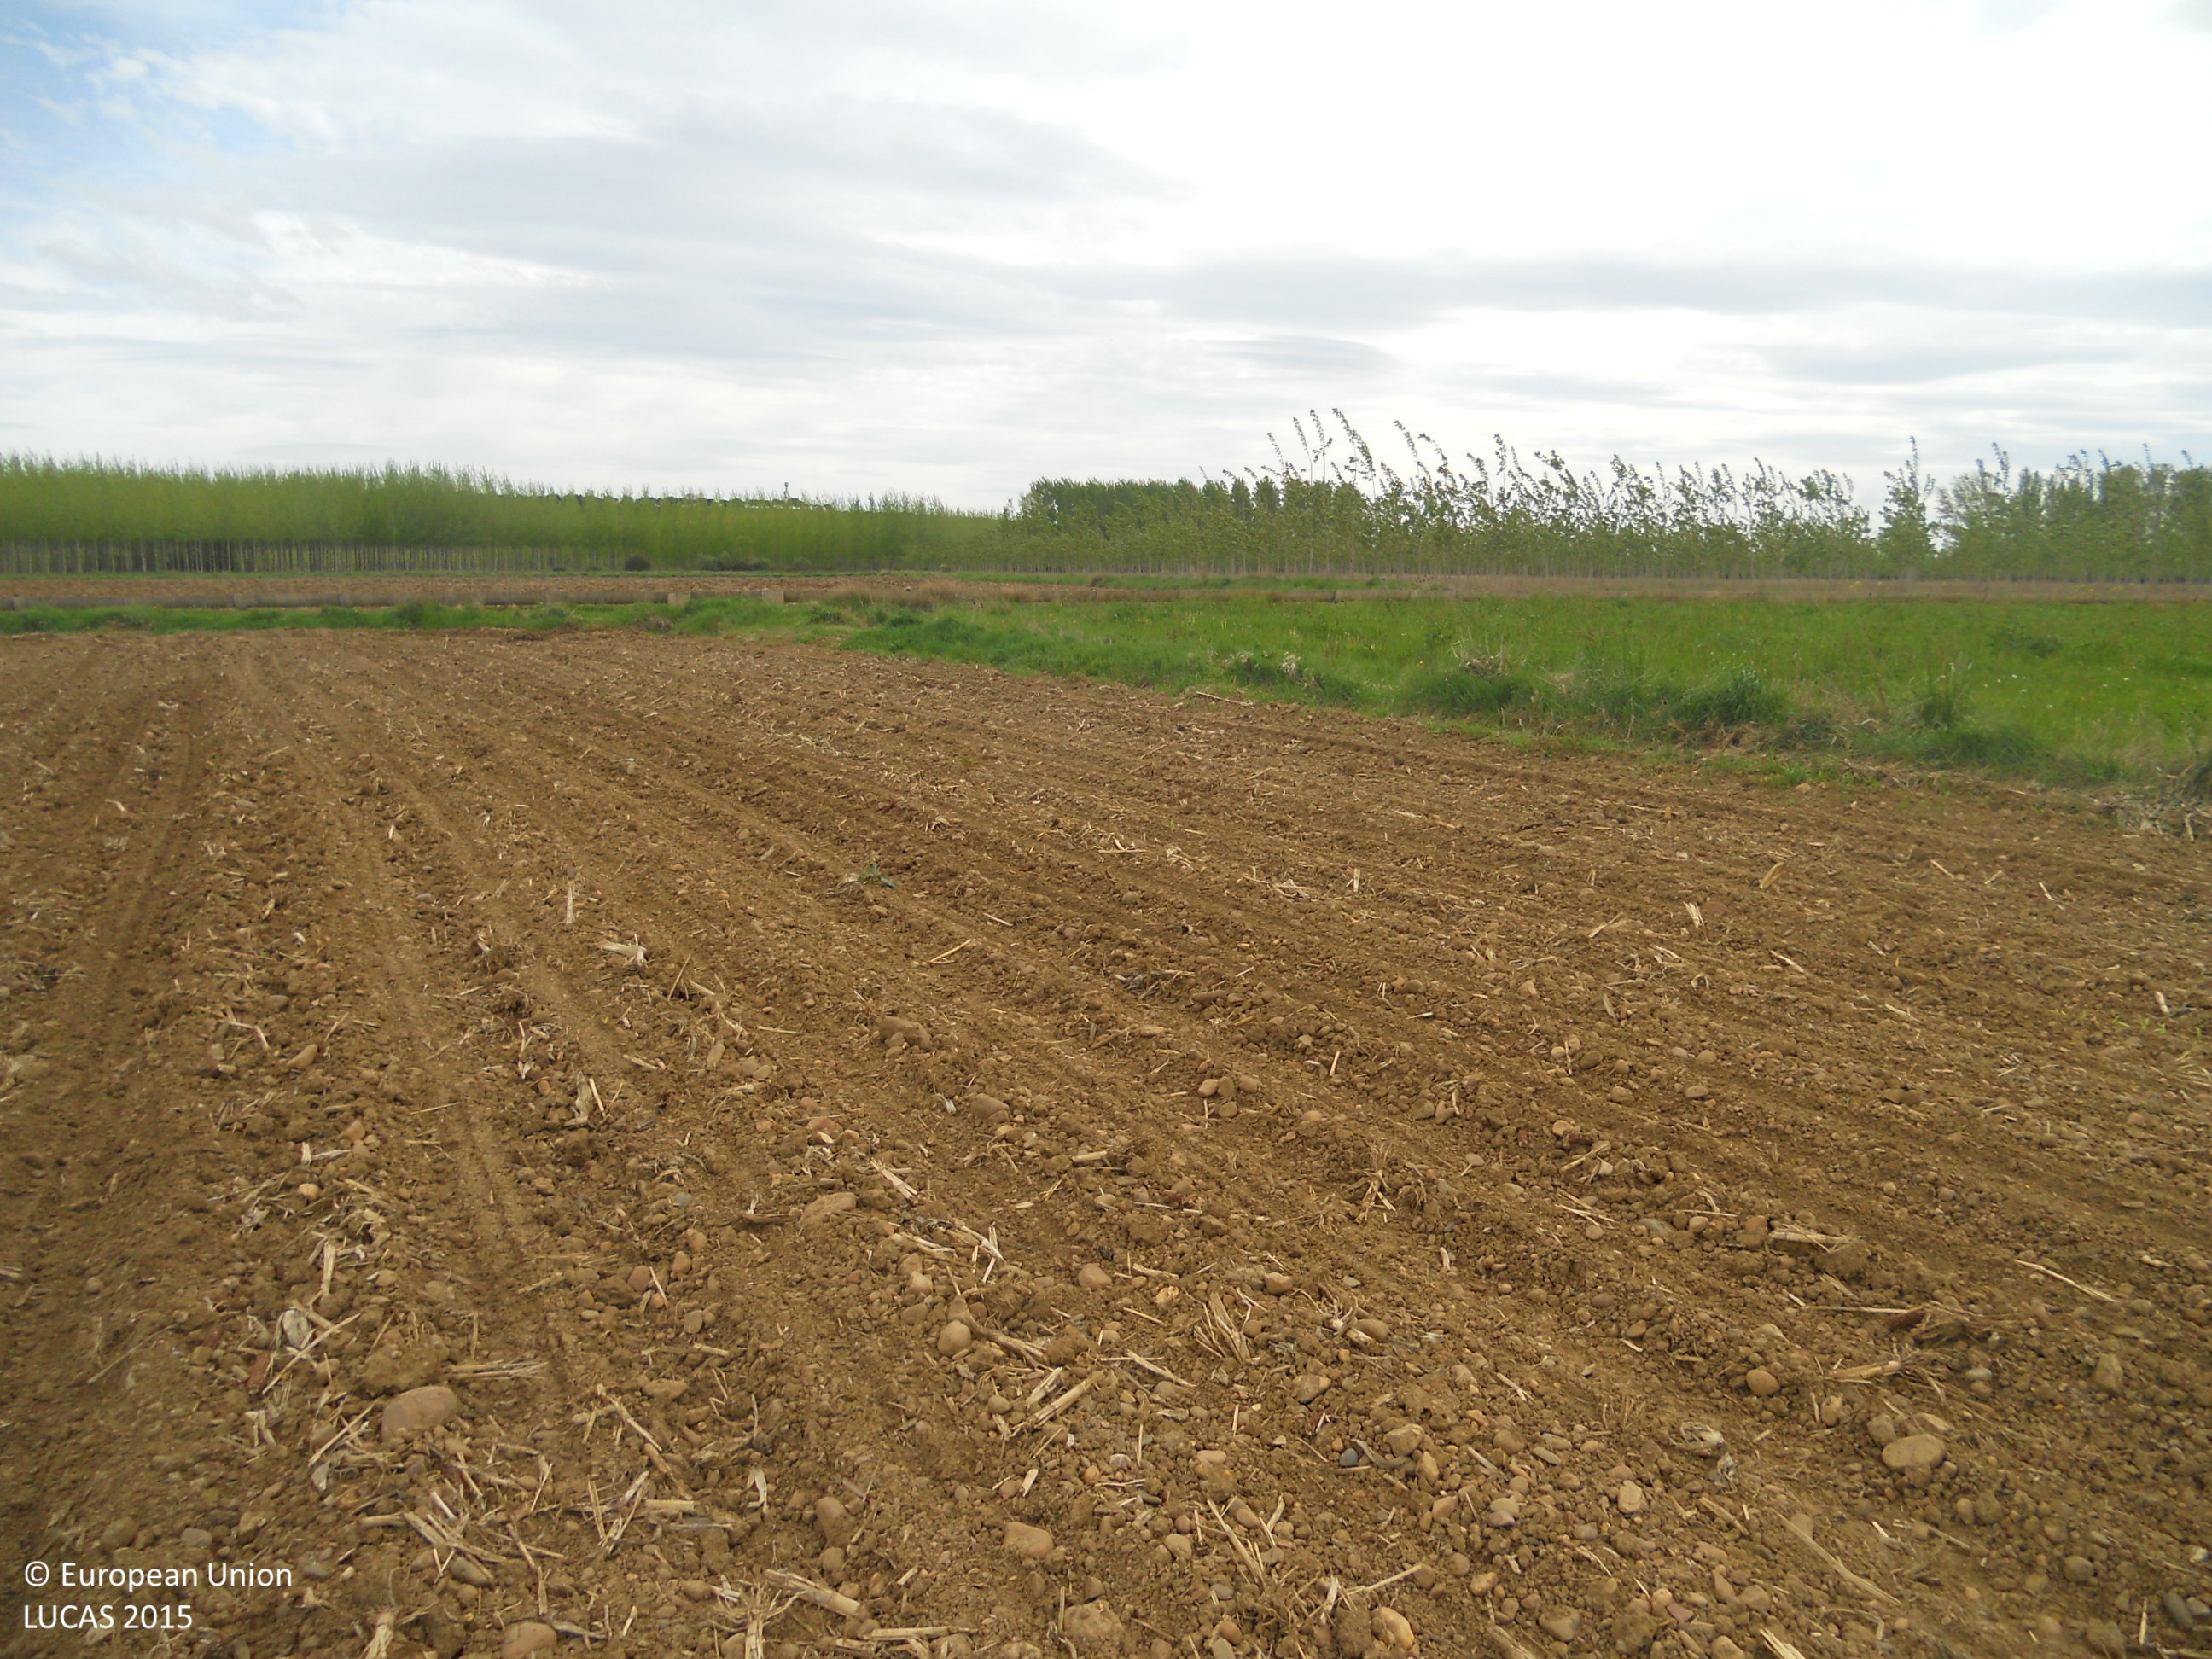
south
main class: Cropland
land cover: Maize
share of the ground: < 10 %
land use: Agriculture (excluding fallow land and kitchen gardens)
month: May
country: ES
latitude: 42.5263
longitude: -5.3203
